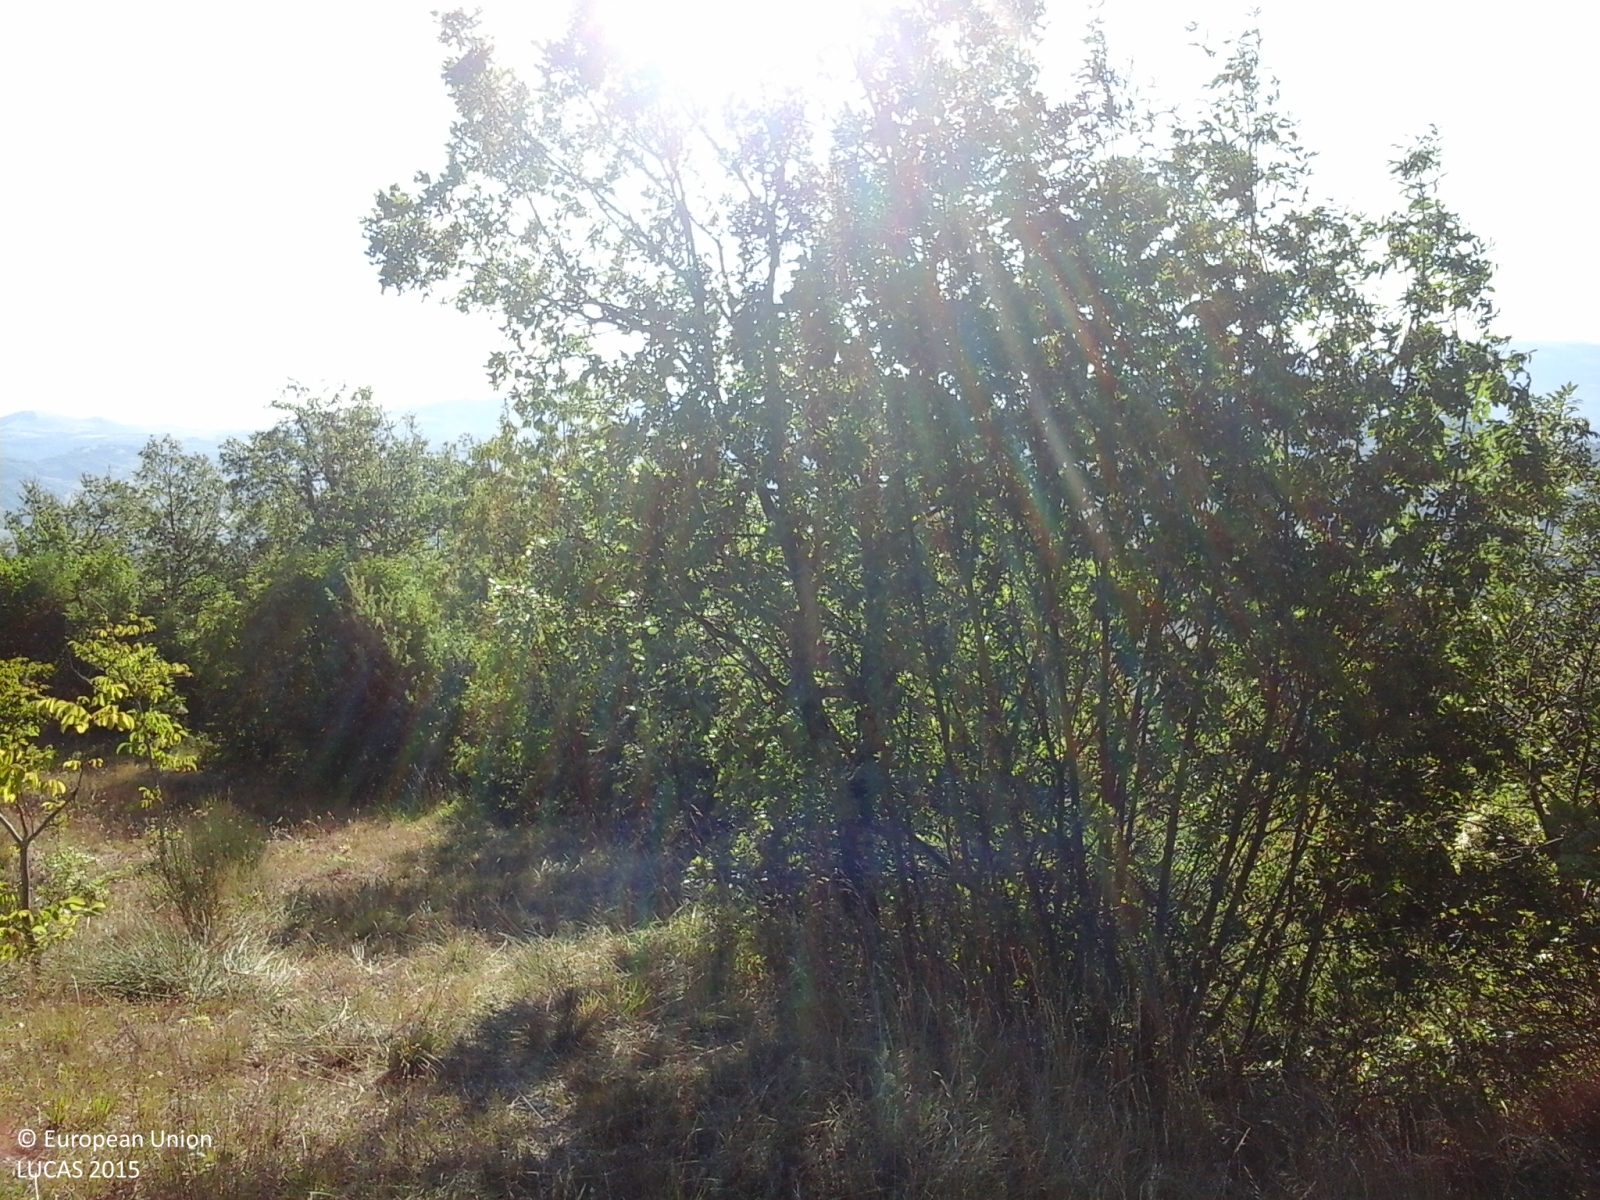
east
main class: Woodland
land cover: Broadleaved woodland
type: thermophilous deciduous forest
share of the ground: > 75 %
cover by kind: broadleaved forest trees 95 %, coniferous forest trees 5 %
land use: Forestry
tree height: > 5 m
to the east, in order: Broadleaved woodland; Olive groves; Broadleaved woodland
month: August
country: IT
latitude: 43.1515
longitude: 13.0045
